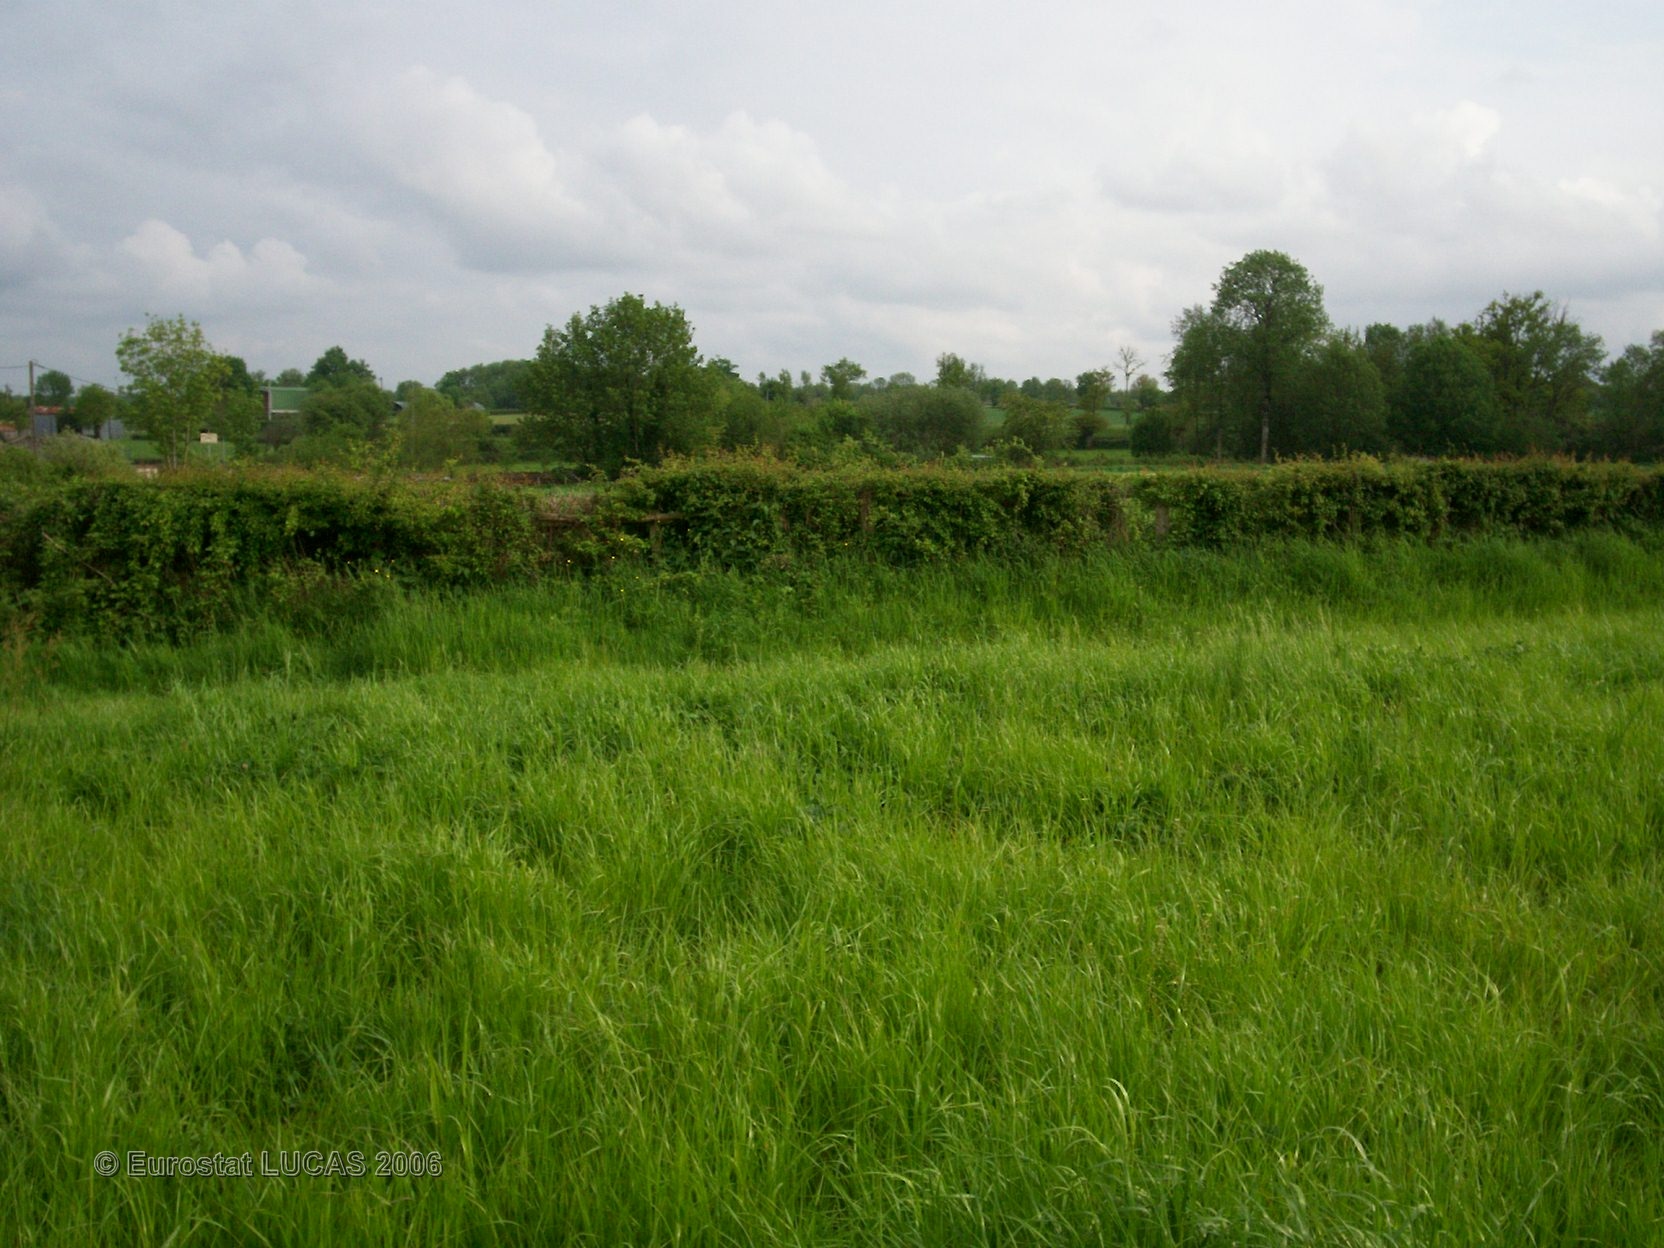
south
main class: Grassland
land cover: Grassland without tree/shrub cover
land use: Agriculture (excluding fallow land and kitchen gardens)
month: April
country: FR
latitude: 46.6835
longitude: -0.3414
